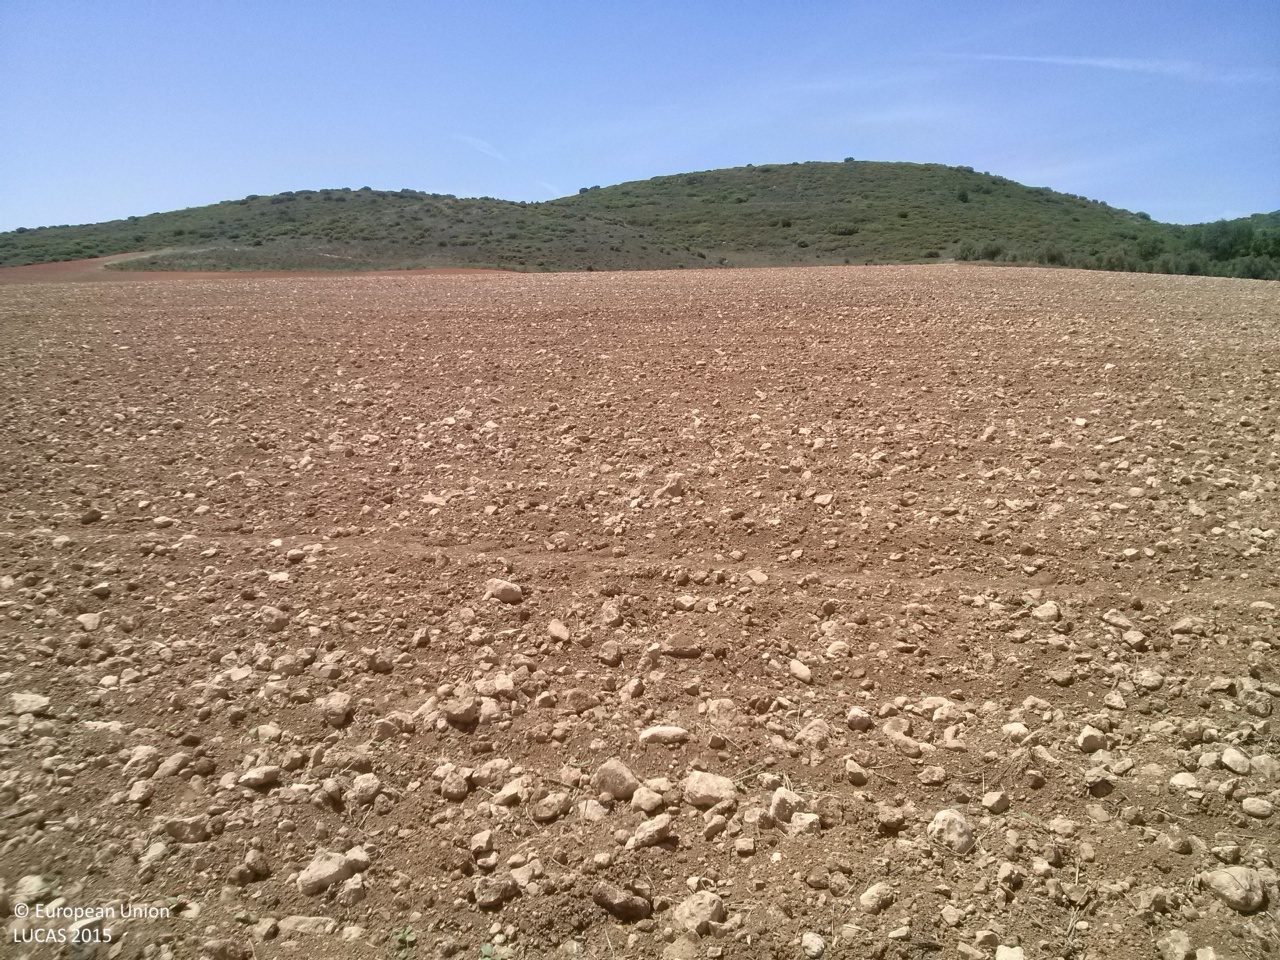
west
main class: Cropland
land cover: Sunflower
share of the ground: < 10 %
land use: Agriculture (excluding fallow land and kitchen gardens)
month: May
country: ES
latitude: 40.0993
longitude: -2.8206
